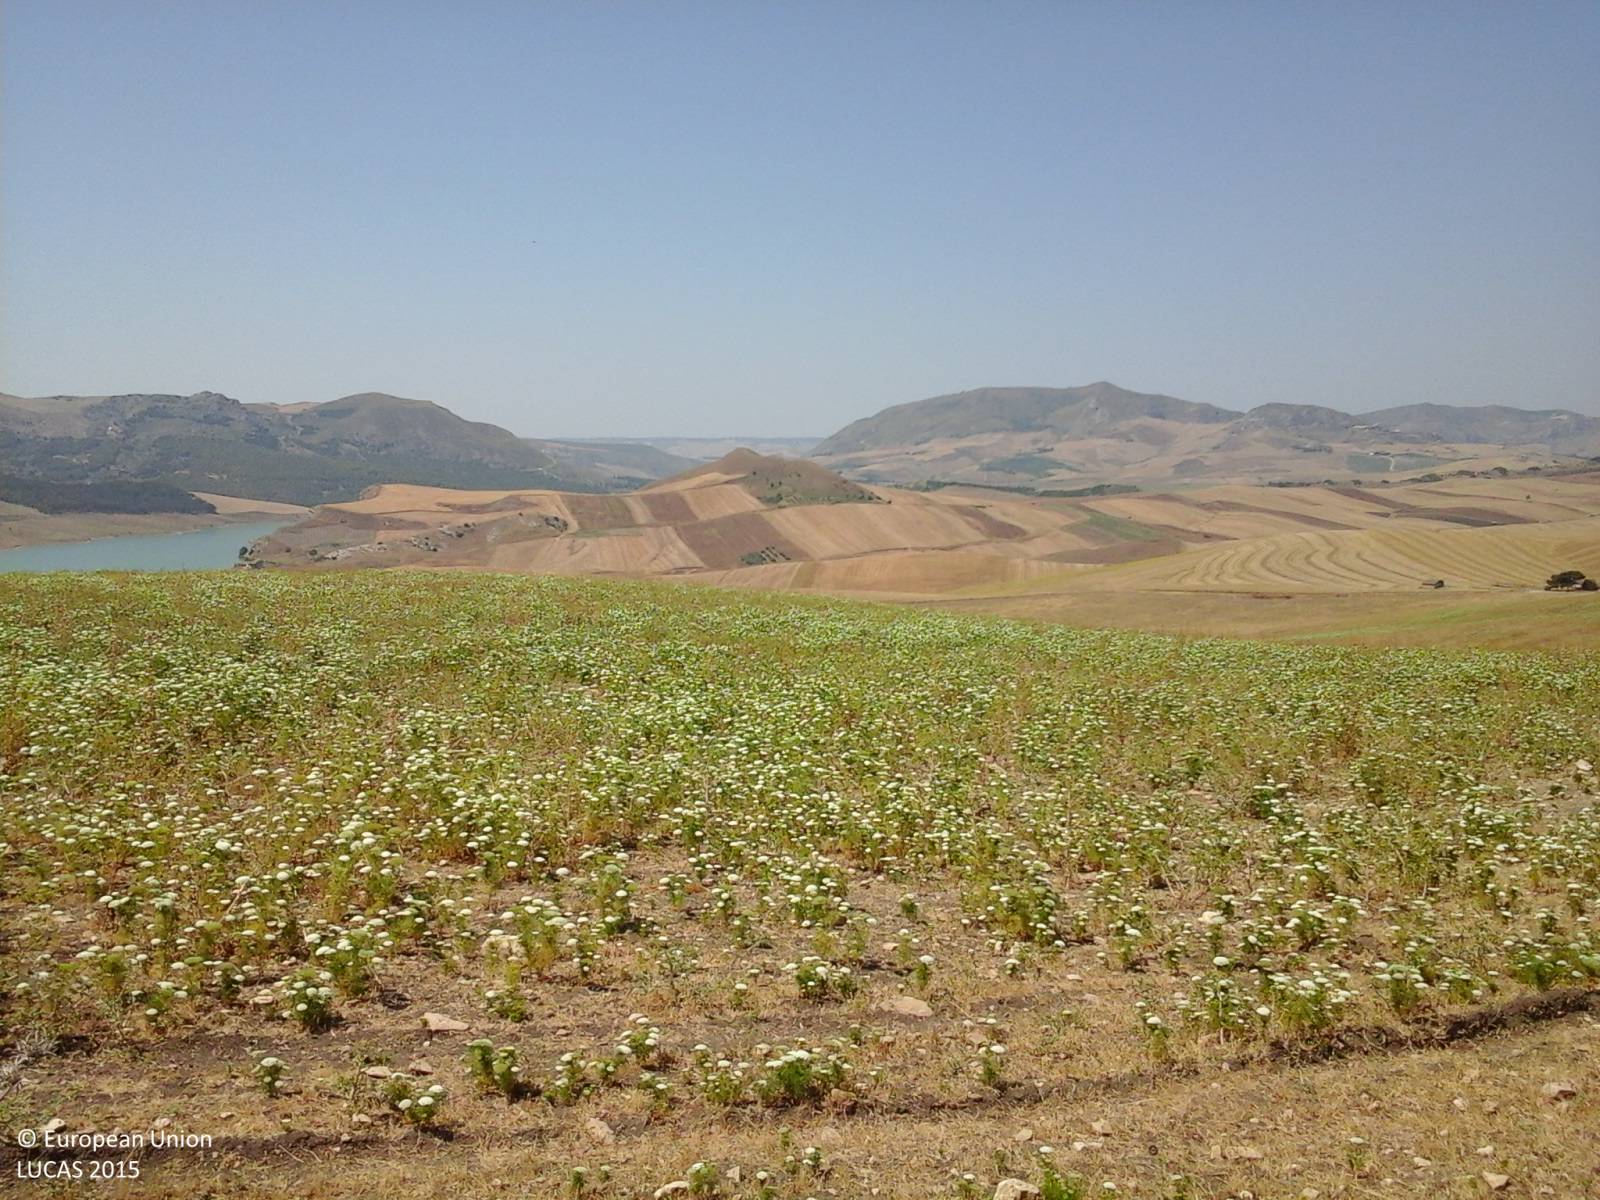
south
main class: Grassland
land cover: Spontaneously vegetated surfaces
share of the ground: > 75 %
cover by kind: herbaceous plants 100 %
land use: Fallow land
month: July
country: IT
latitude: 37.8227
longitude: 13.1465
